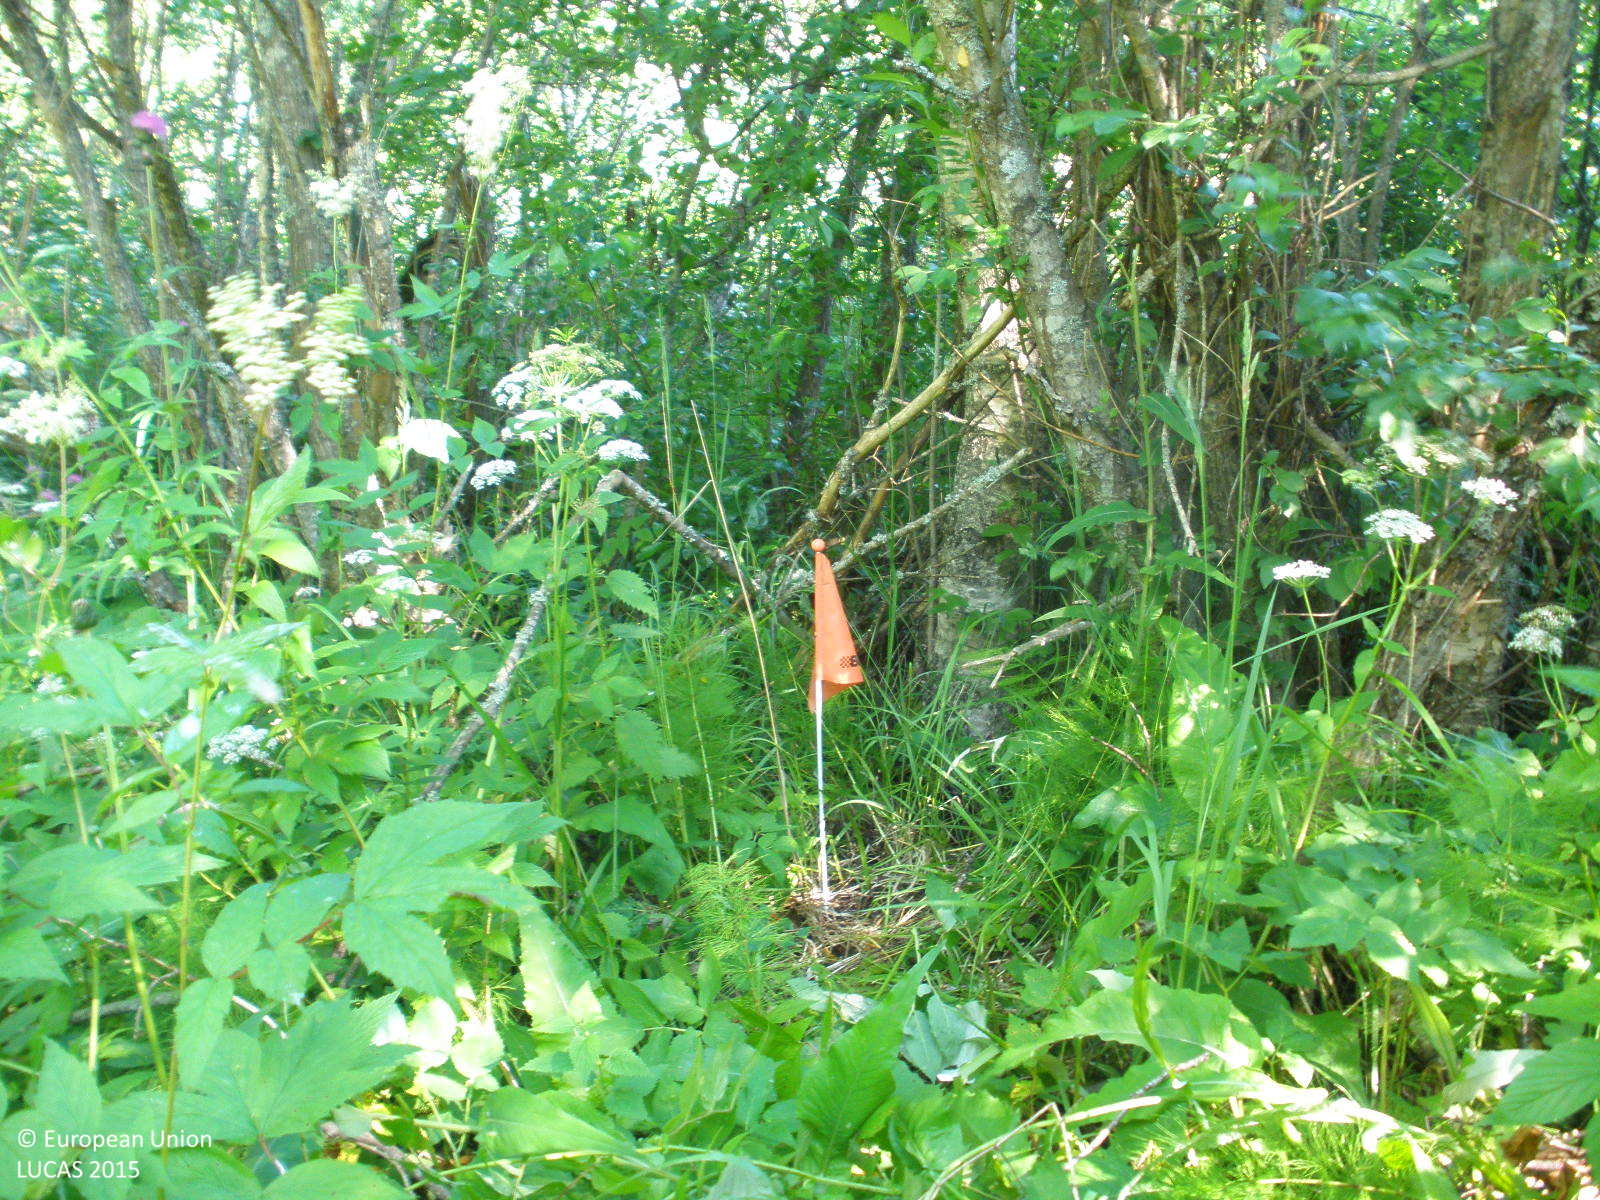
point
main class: Woodland
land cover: Broadleaved woodland
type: boreal forest
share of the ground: > 75 %
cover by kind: broadleaved forest trees 80 %, shrubs 10 %, coniferous forest trees 5 %, herbaceous plants 5 %
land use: Forestry
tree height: > 5 m
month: July
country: FI
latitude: 61.0641
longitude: 24.9909
